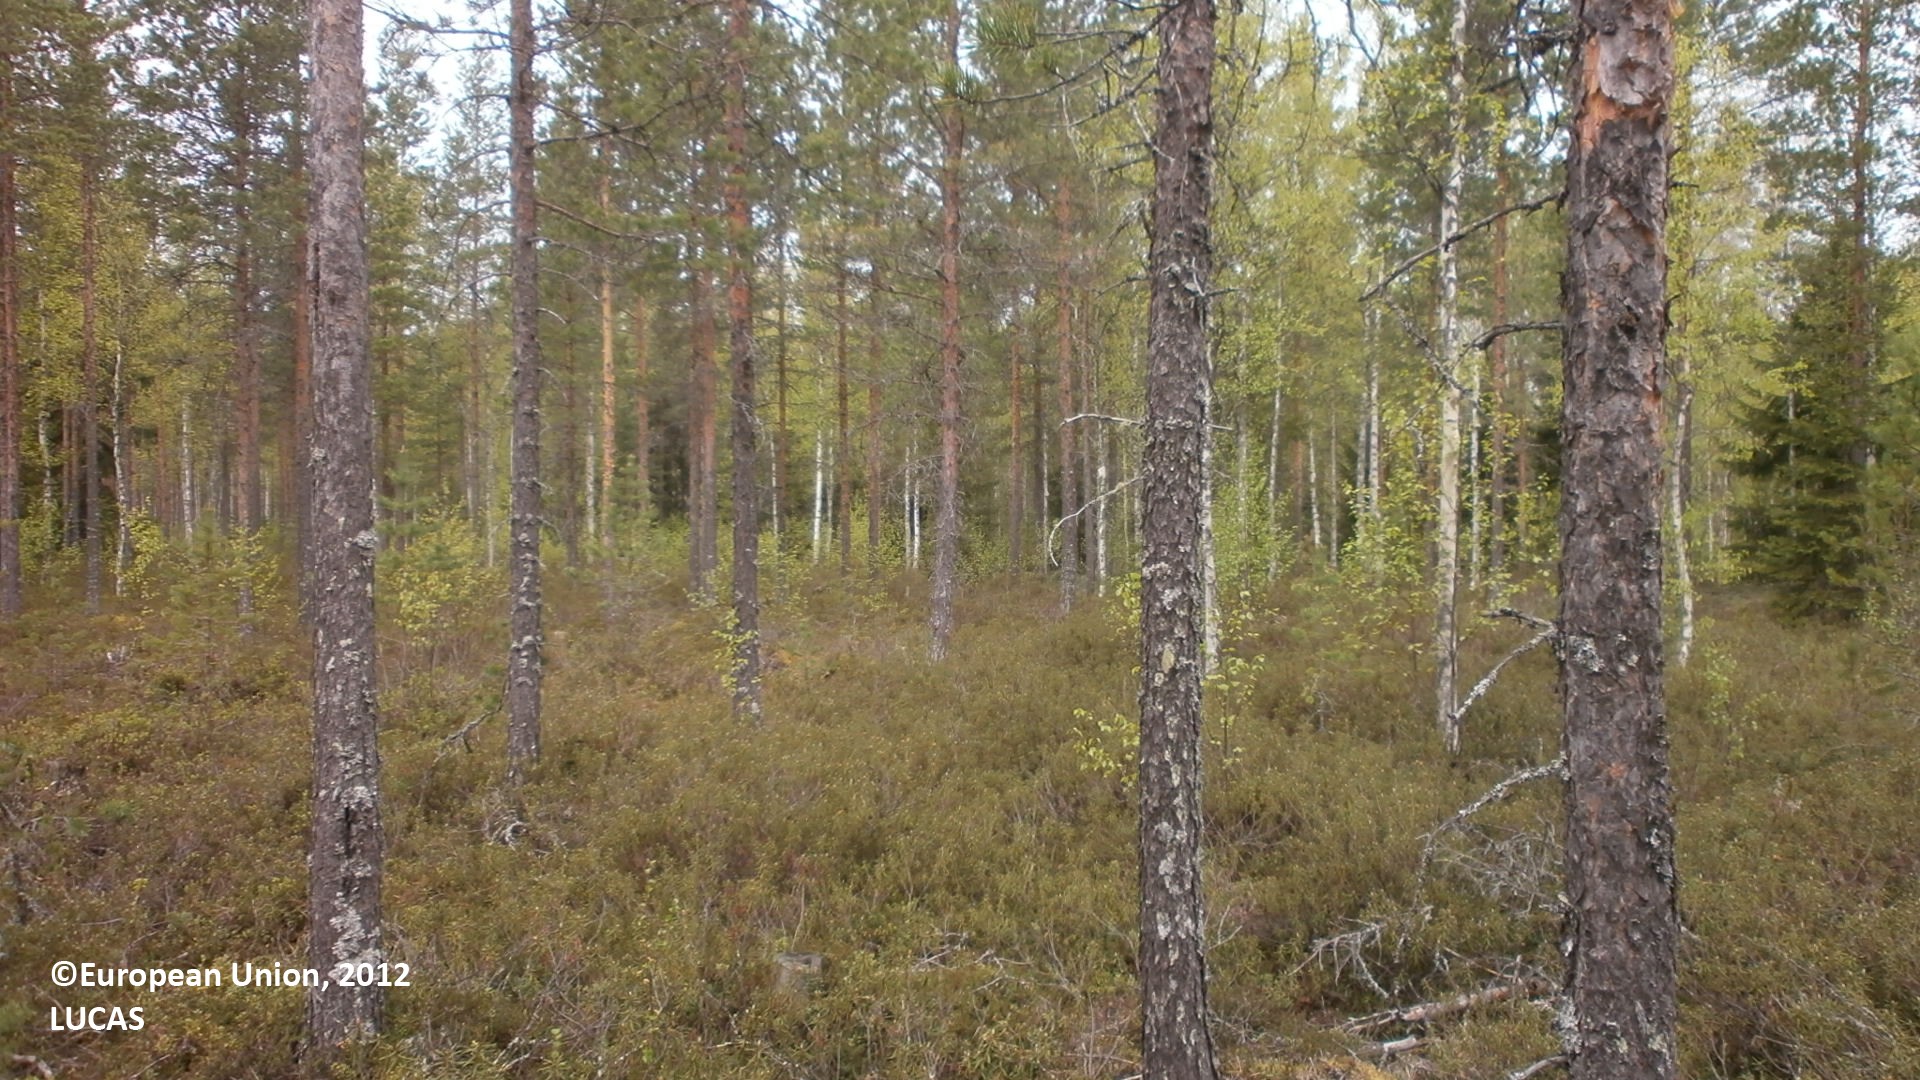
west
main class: Woodland
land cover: Pine dominated coniferous woodland
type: mire and swamp forests
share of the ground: 25 - 50 %
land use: Forestry
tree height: > 5 m
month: June
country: FI
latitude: 64.3169
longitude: 25.8377
